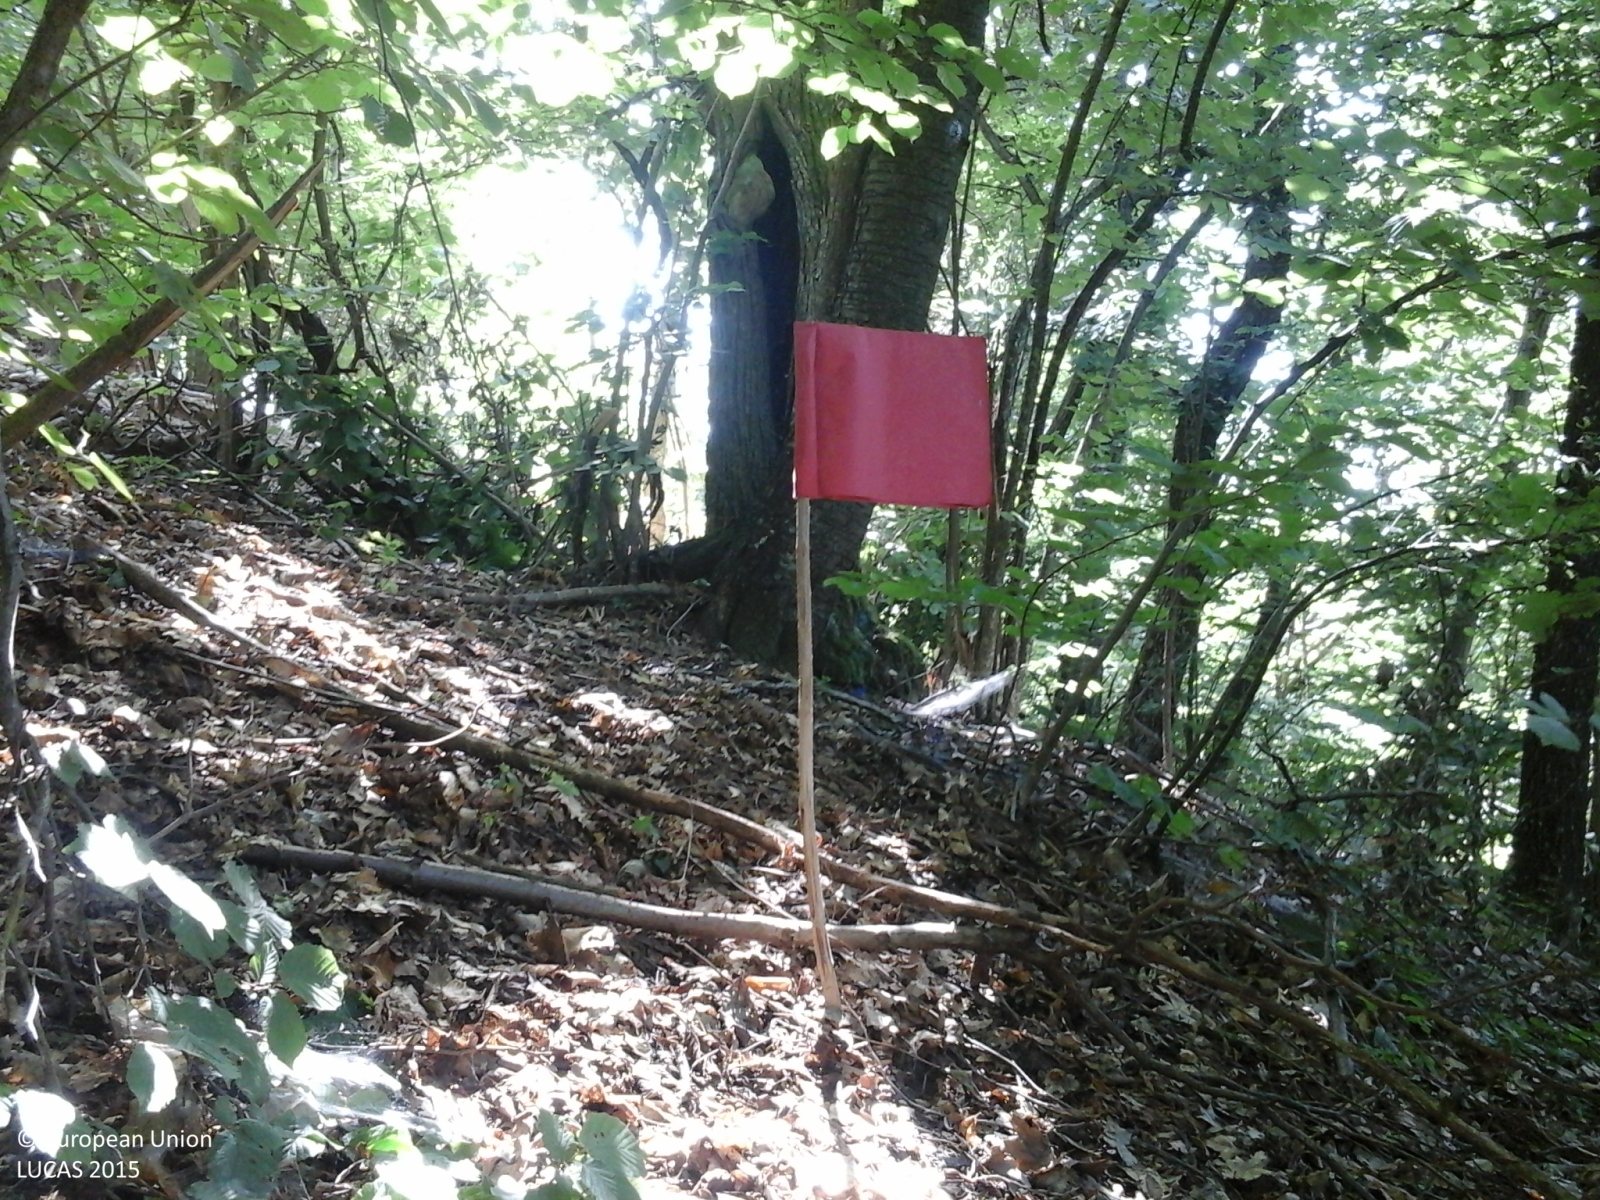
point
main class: Woodland
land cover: Broadleaved woodland
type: thermophilous deciduous forest
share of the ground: > 75 %
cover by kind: broadleaved forest trees 100 %
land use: Forestry
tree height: > 5 m
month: June
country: IT
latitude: 44.5884
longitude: 8.2528
